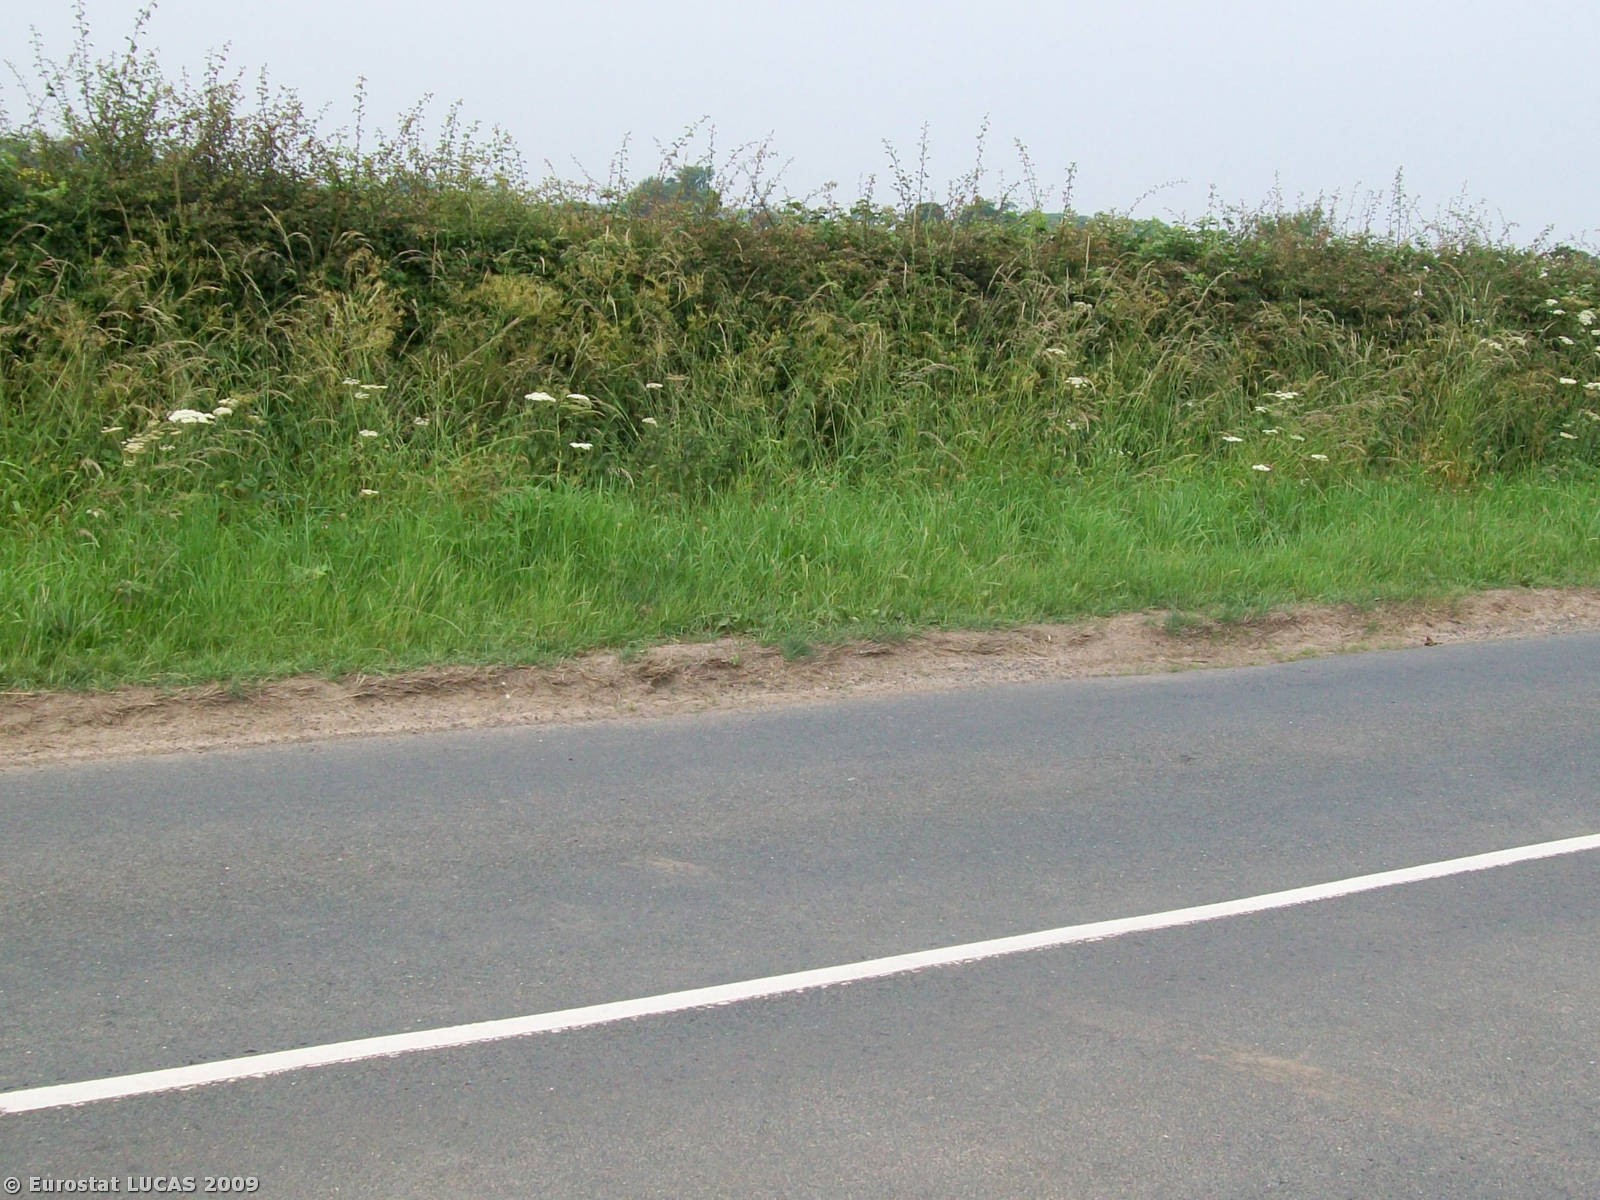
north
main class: Artificial land
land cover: Non built-up linear features
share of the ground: > 75 %
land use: Road transport
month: June
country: GB
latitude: 54.0549
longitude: -1.4597
